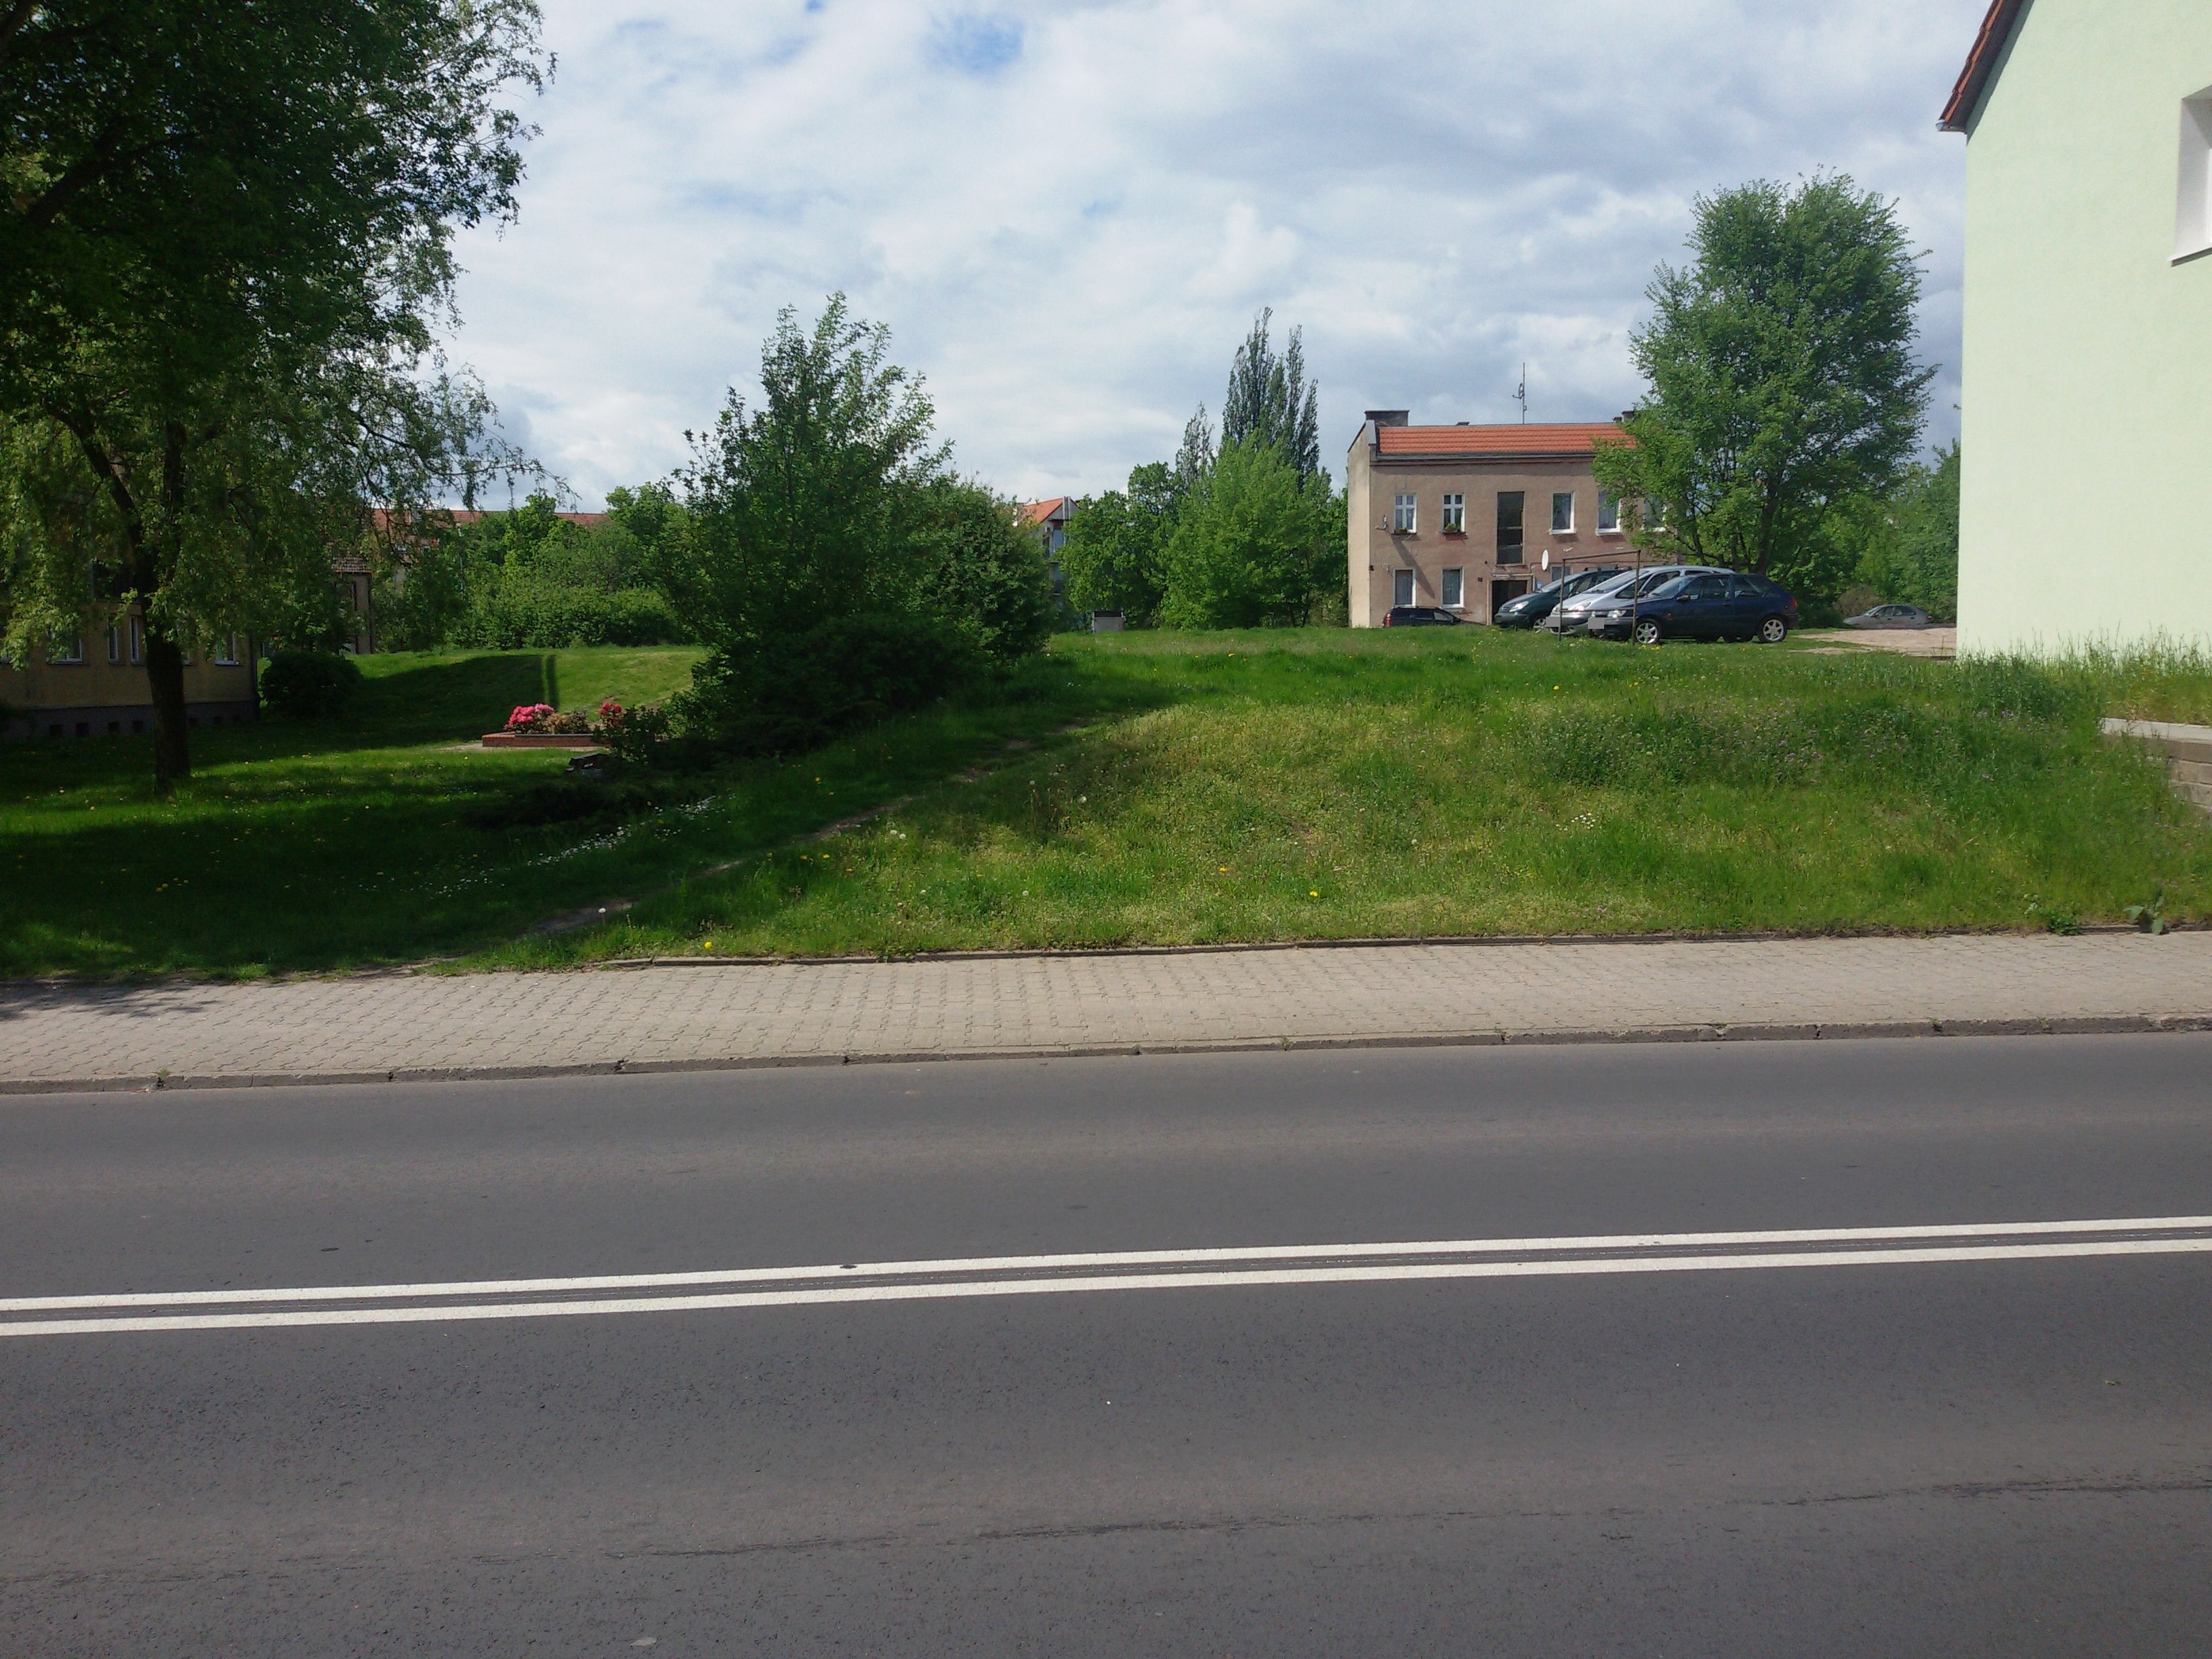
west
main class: Grassland
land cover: Grassland with sparse tree/shrub cover
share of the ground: > 75 %
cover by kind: herbaceous plants 85 %, shrubs 10 %, broadleaved forest trees 5 %
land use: Residential
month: May
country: PL
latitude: 53.5496
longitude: 14.5744
